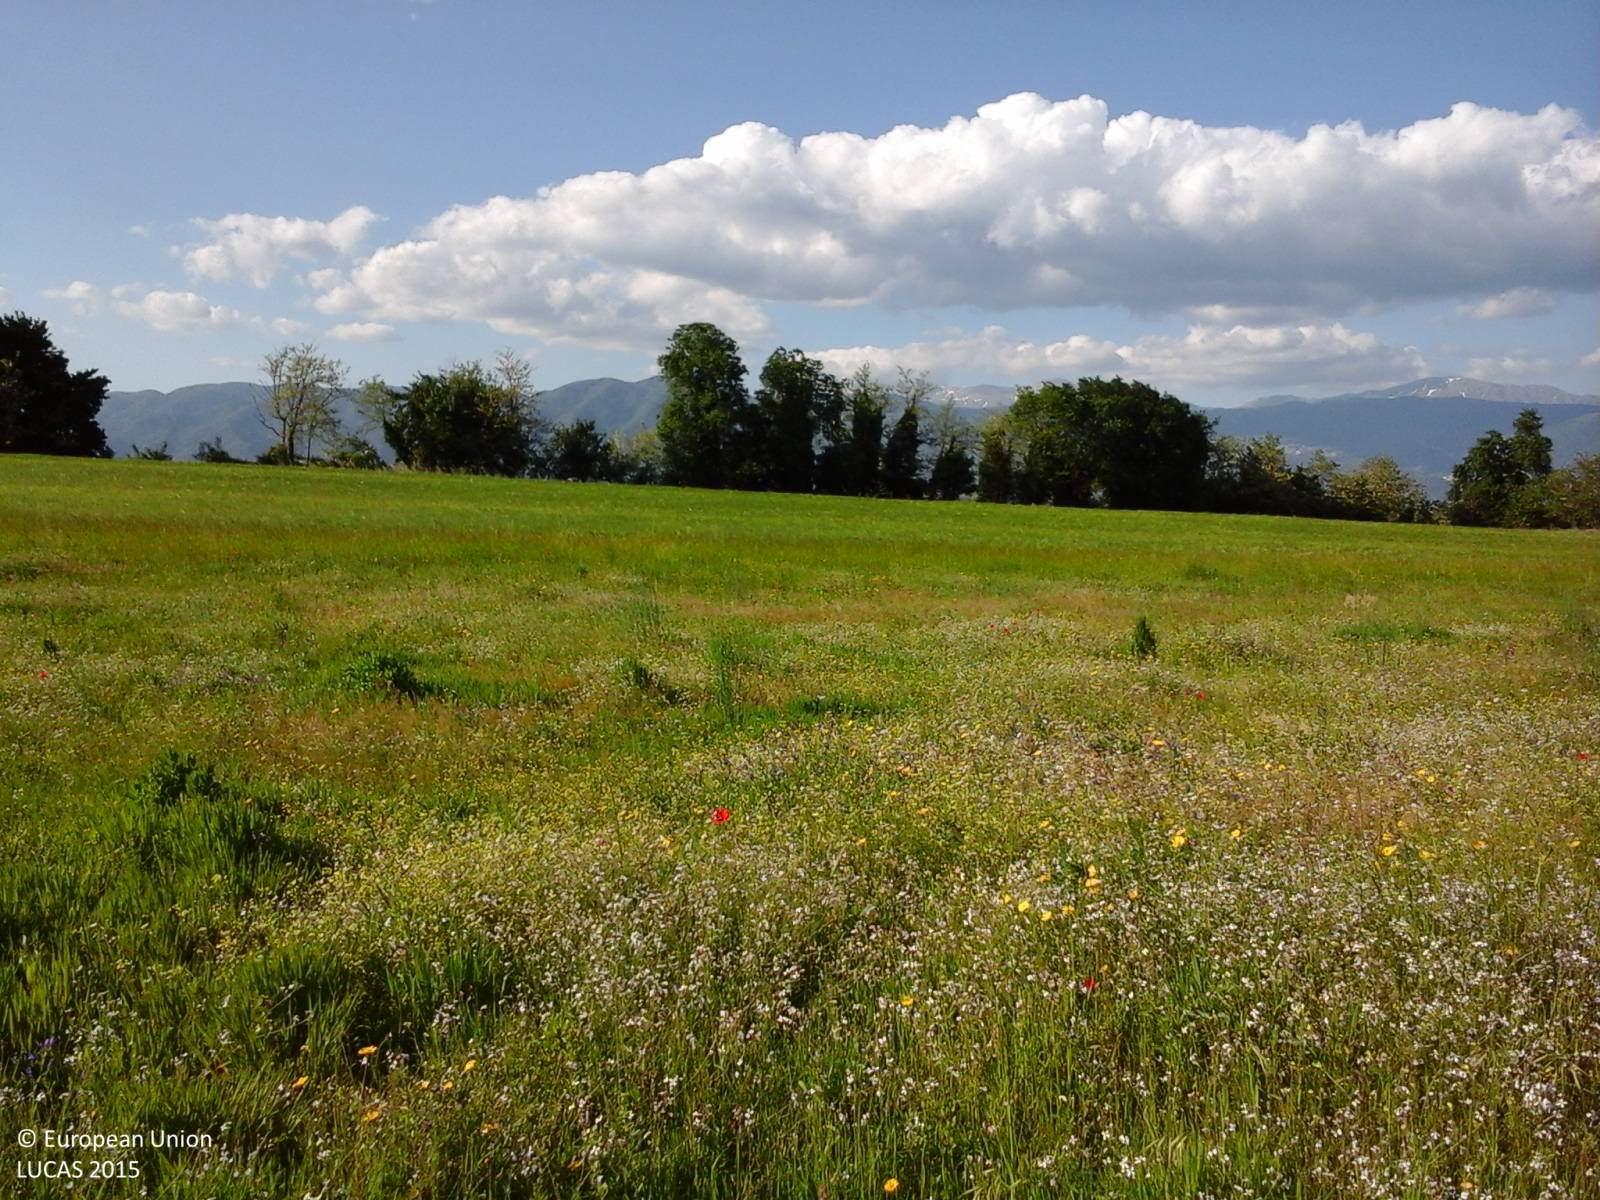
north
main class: Grassland
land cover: Spontaneously vegetated surfaces
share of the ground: > 75 %
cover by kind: herbaceous plants 100 %
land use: Agriculture (excluding fallow land and kitchen gardens)
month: May
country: IT
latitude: 41.2773
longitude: 14.3173
